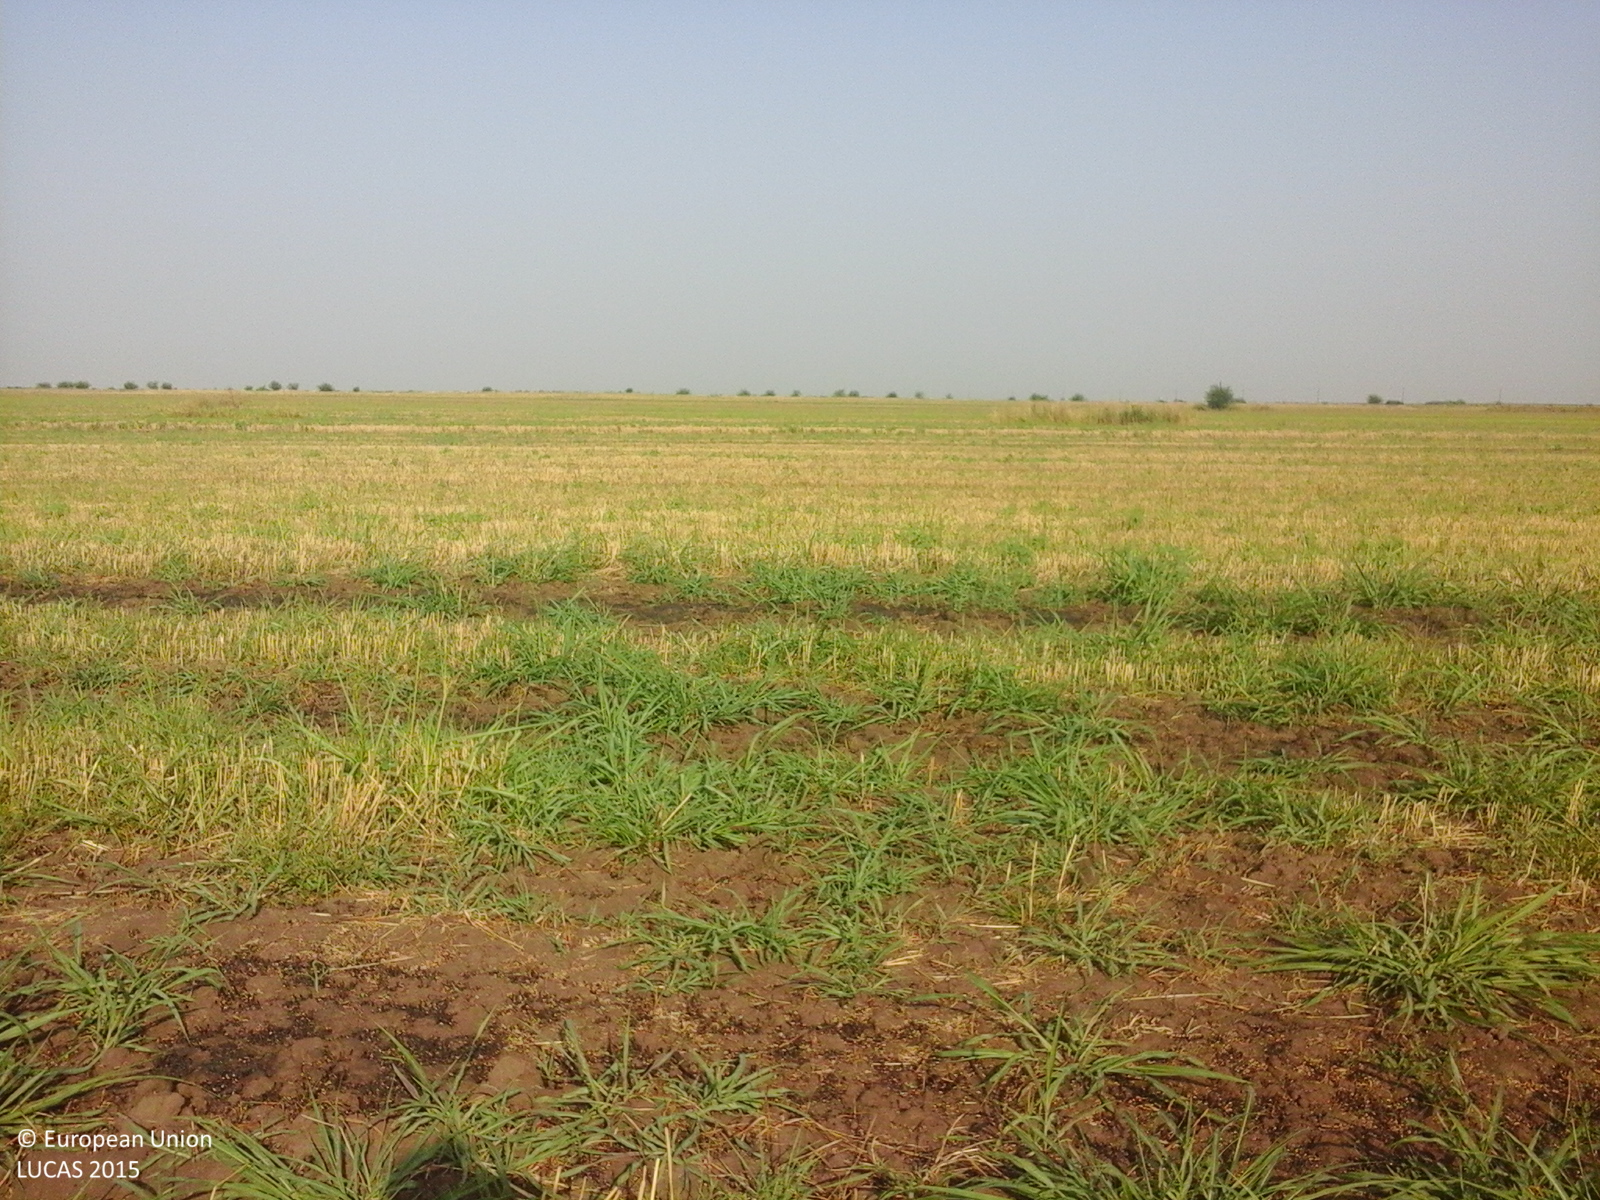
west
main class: Cropland
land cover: Common wheat
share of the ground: 50 - 75 %
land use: Agriculture (excluding fallow land and kitchen gardens)
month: August
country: RO
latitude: 44.0042
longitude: 23.2782
